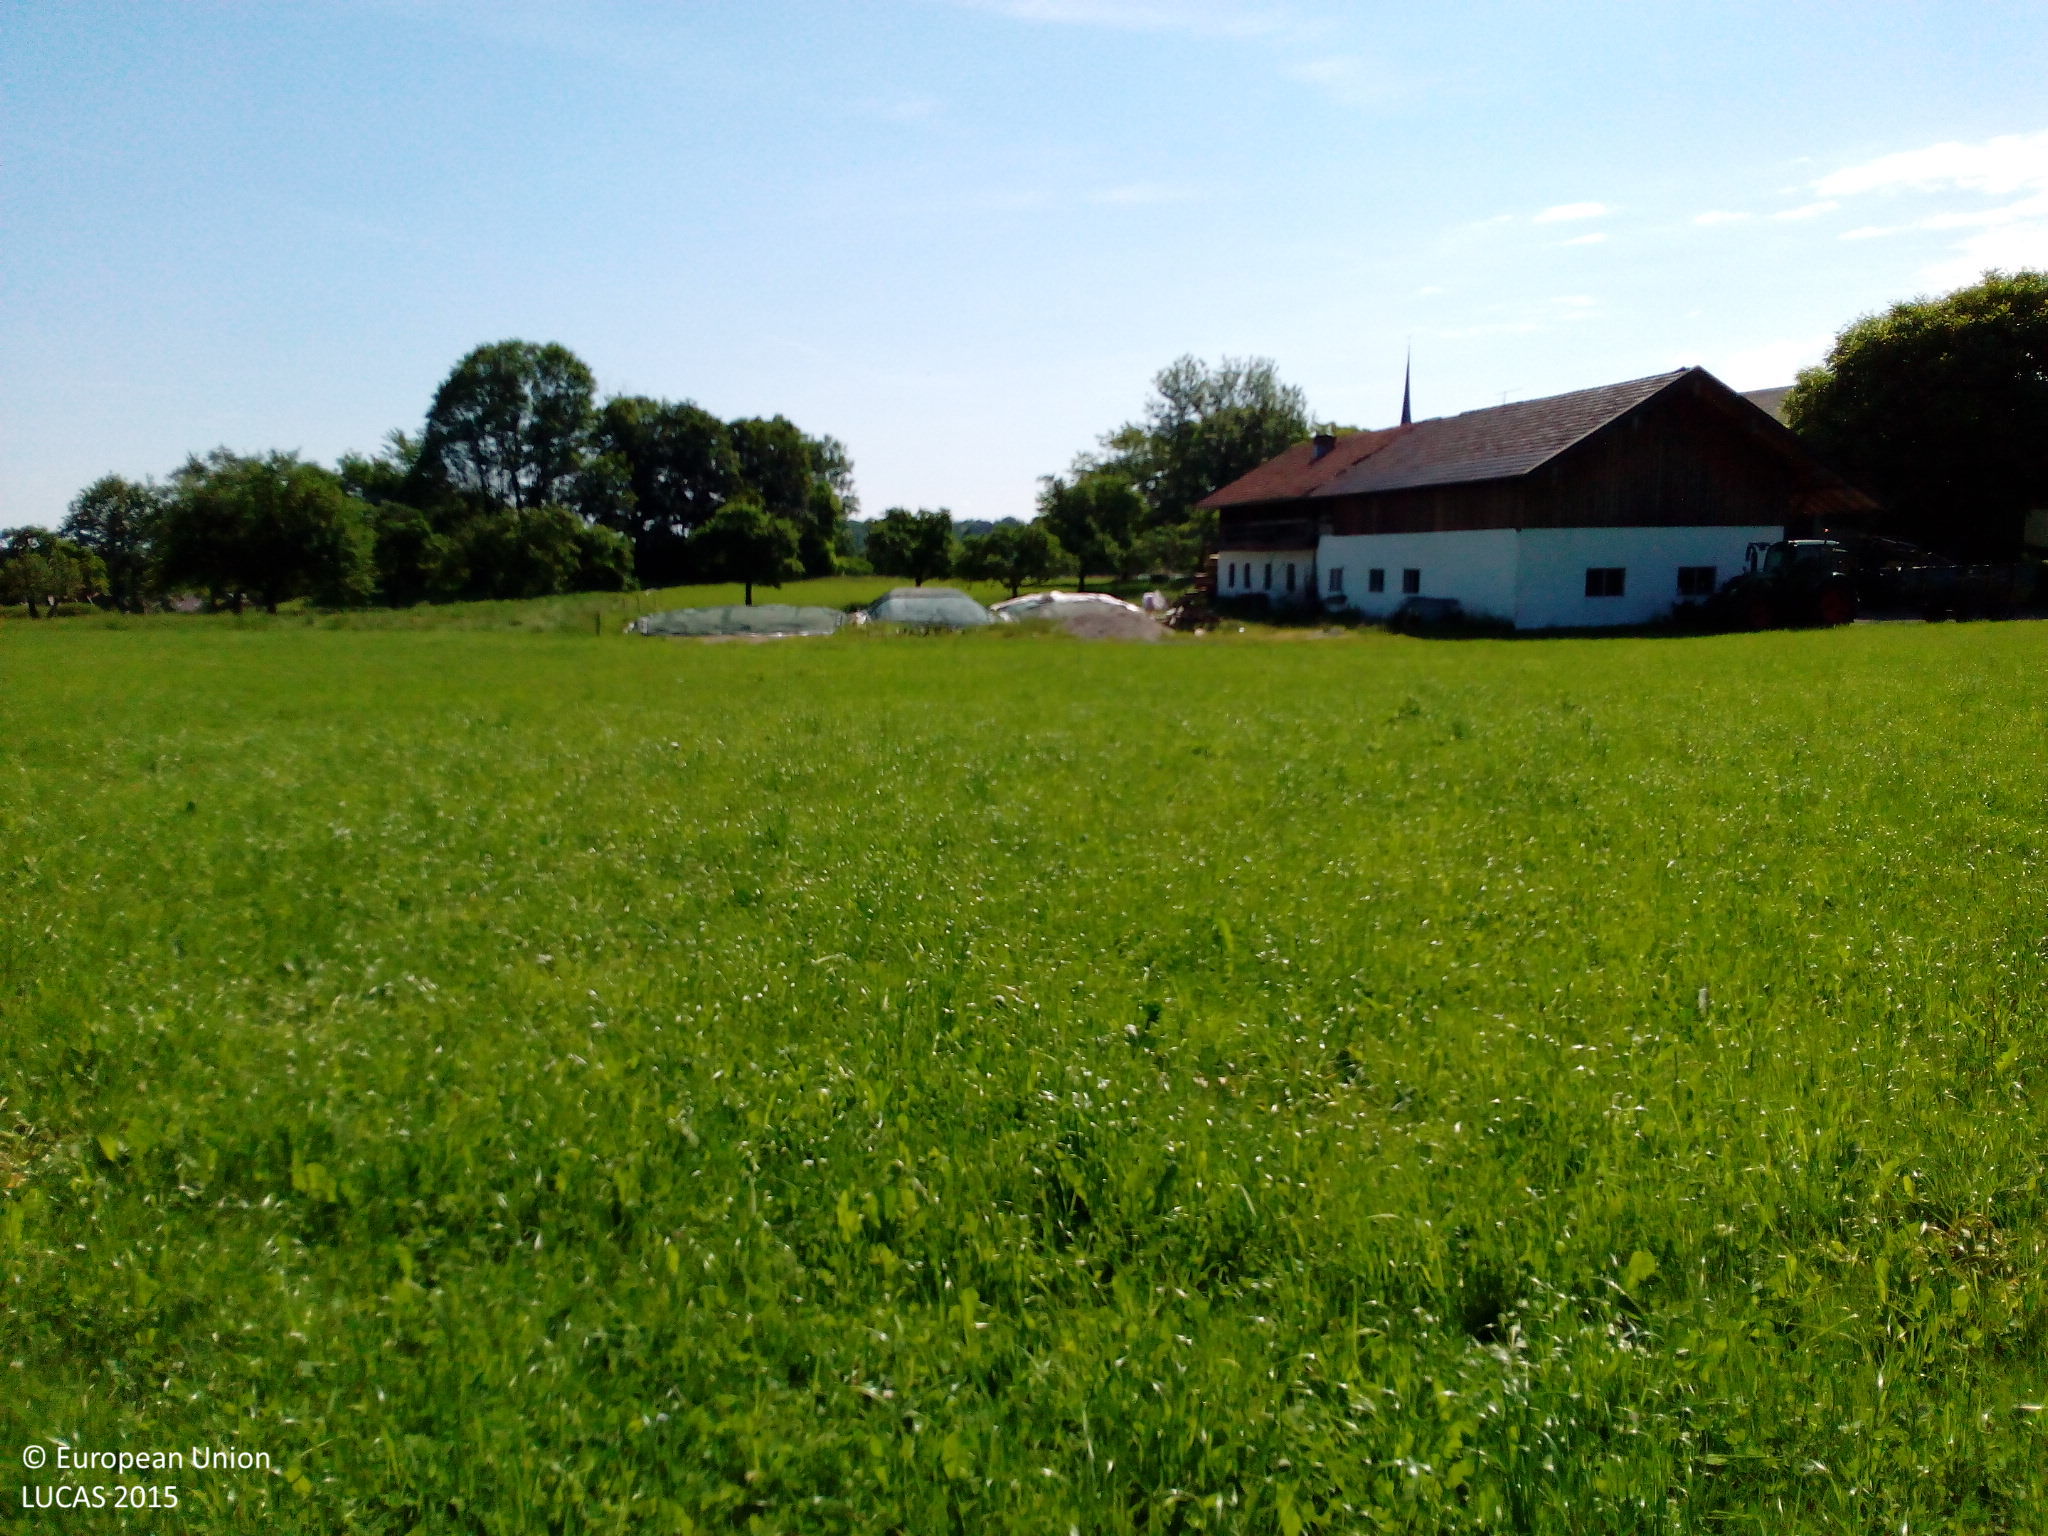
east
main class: Grassland
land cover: Grassland without tree/shrub cover
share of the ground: > 75 %
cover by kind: herbaceous plants 100 %
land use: Agriculture (excluding fallow land and kitchen gardens)
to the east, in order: Grassland without tree/shrub cover; Artificial constructions in urban areas; Broadleaved woodland; Grassland without tree/shrub cover; Fences; Grassland without tree/shrub cover; Artificial constructions in urban areas
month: June
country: DE
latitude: 47.8567
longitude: 12.3377
